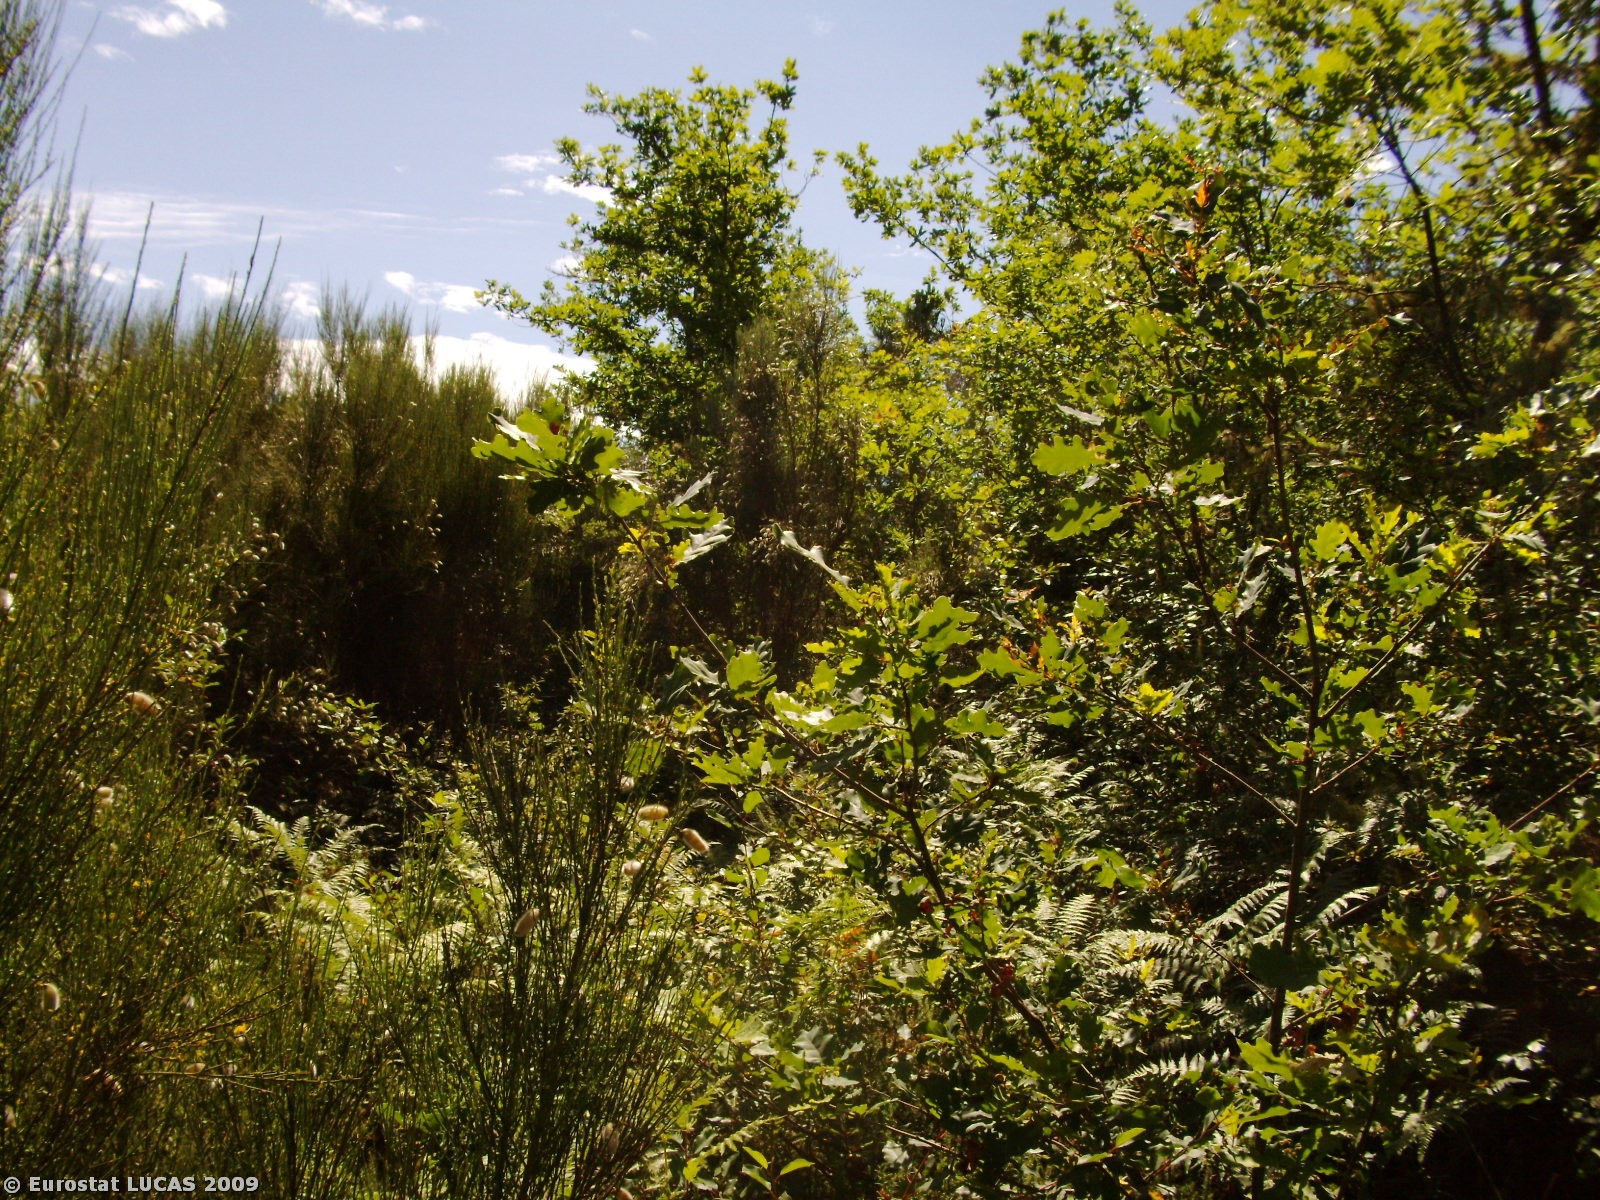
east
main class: Woodland
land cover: Broadleaved woodland
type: mesophytic deciduous forest
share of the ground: > 75 %
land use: Forestry
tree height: > 5 m
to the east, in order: Broadleaved woodland; Dry stone walls; Tracks; Dry stone walls; Shrubland with sparse tree cover; Dry stone walls; Tracks; Dry stone walls; Broadleaved woodland; Dry stone walls; Tracks; Dry stone walls; Mixed woodland; Dry stone walls; Broadleaved woodland; Rock outcrops; Broadleaved woodland; Rock outcrops; Broadleaved woodland; Rivers and streams; Broadleaved woodland
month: July
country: PT
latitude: 40.8430
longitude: -7.6868
